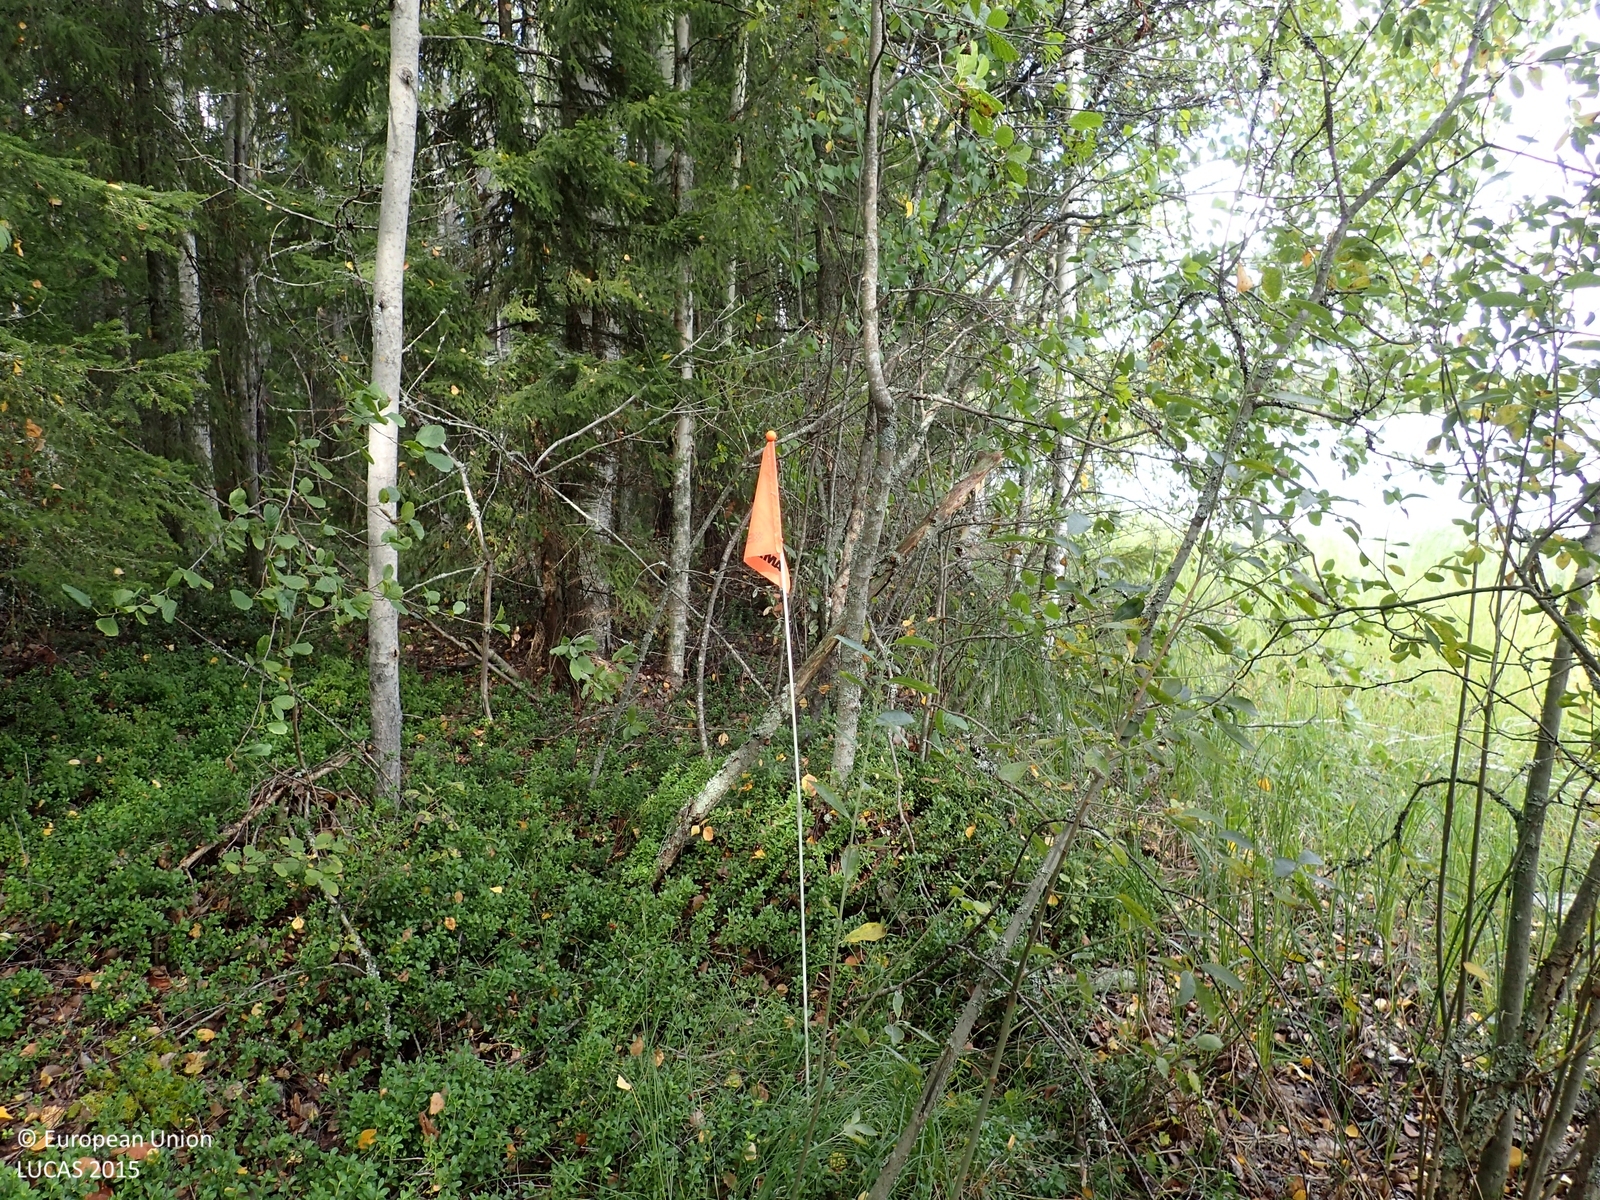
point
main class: Woodland
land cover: Spruce dominated mixed woodland
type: boreal forest
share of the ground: > 75 %
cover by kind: broadleaved forest trees 50 %, coniferous forest trees 30 %, shrubs 15 %, lichens and mosses 5 %
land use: Forestry
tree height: > 5 m
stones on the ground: < 10 %
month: September
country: FI
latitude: 62.9549
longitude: 25.9479
